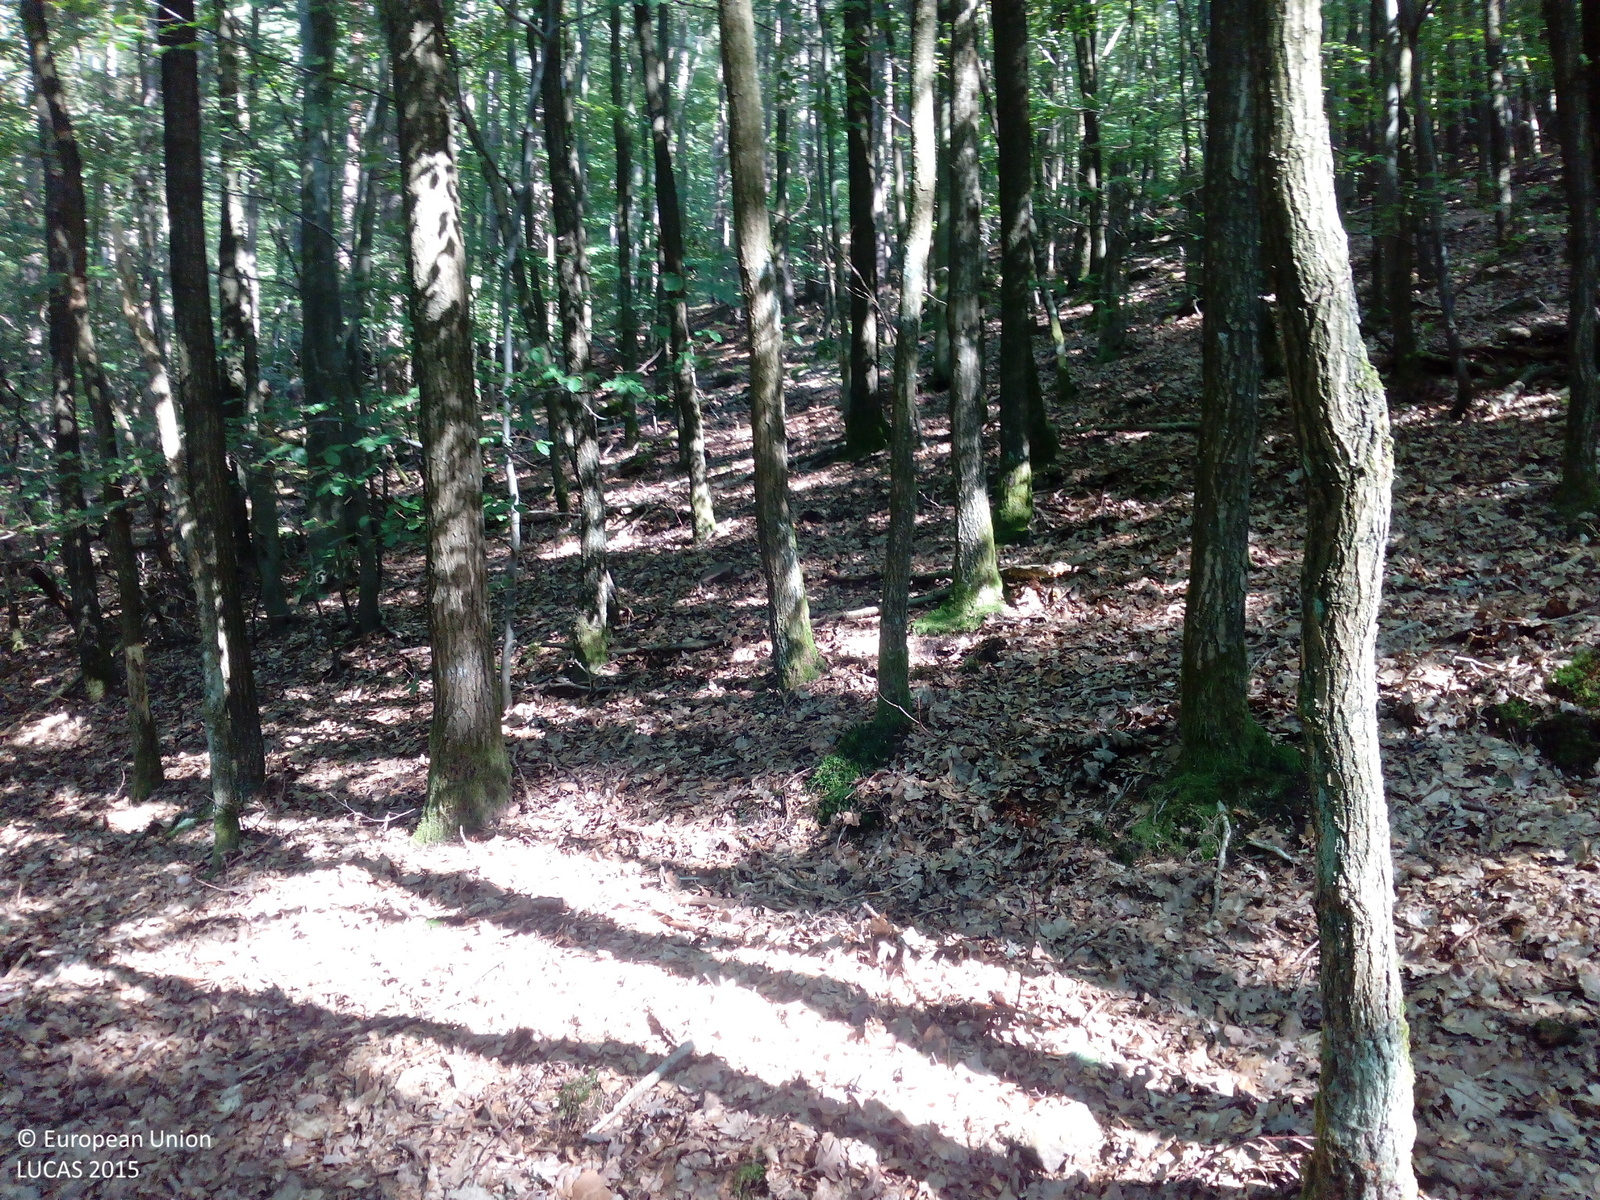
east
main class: Woodland
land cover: Broadleaved woodland
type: acidophilous oak and oak-birch forest
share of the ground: > 75 %
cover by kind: broadleaved forest trees 90 %, unconsolidated bare surface 10 %
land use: Forestry
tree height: > 5 m
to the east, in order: Broadleaved woodland; Tracks; Other mixed woodland; Tracks; Other mixed woodland; Tracks; Other mixed woodland; Tracks; Other mixed woodland; Tracks; Broadleaved woodland; Tracks; Broadleaved woodland
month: September
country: DE
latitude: 49.8410
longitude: 9.4023
